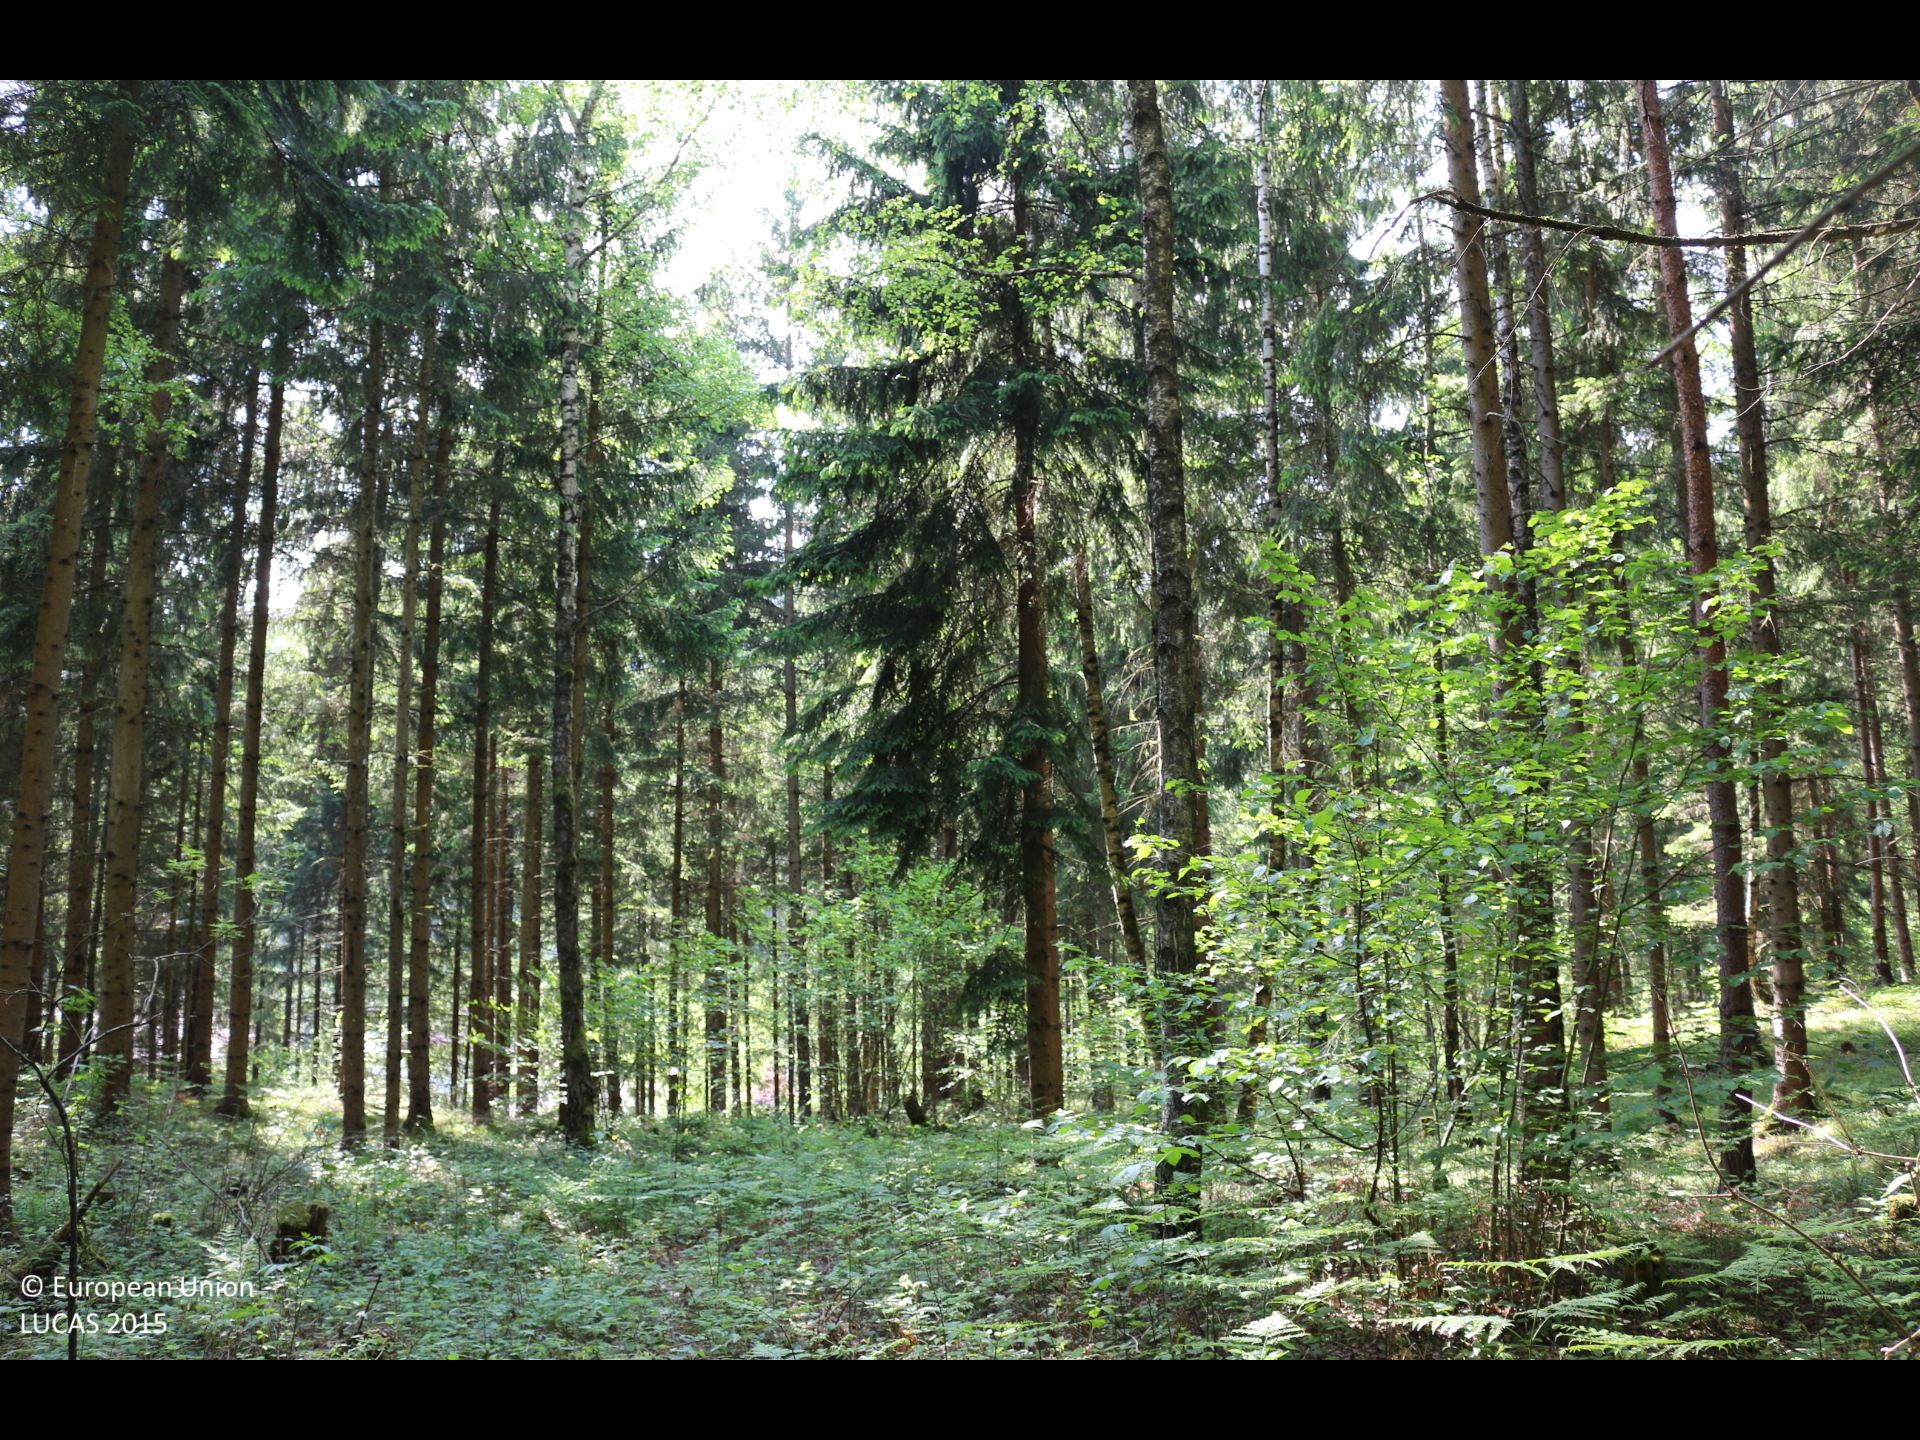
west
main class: Woodland
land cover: Spruce dominated coniferous woodland
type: alpine coniferous forest
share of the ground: > 75 %
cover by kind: coniferous forest trees 95 %, broadleaved forest trees 5 %
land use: Forestry
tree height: > 5 m
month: May
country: AT
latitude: 46.7685
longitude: 14.3321
